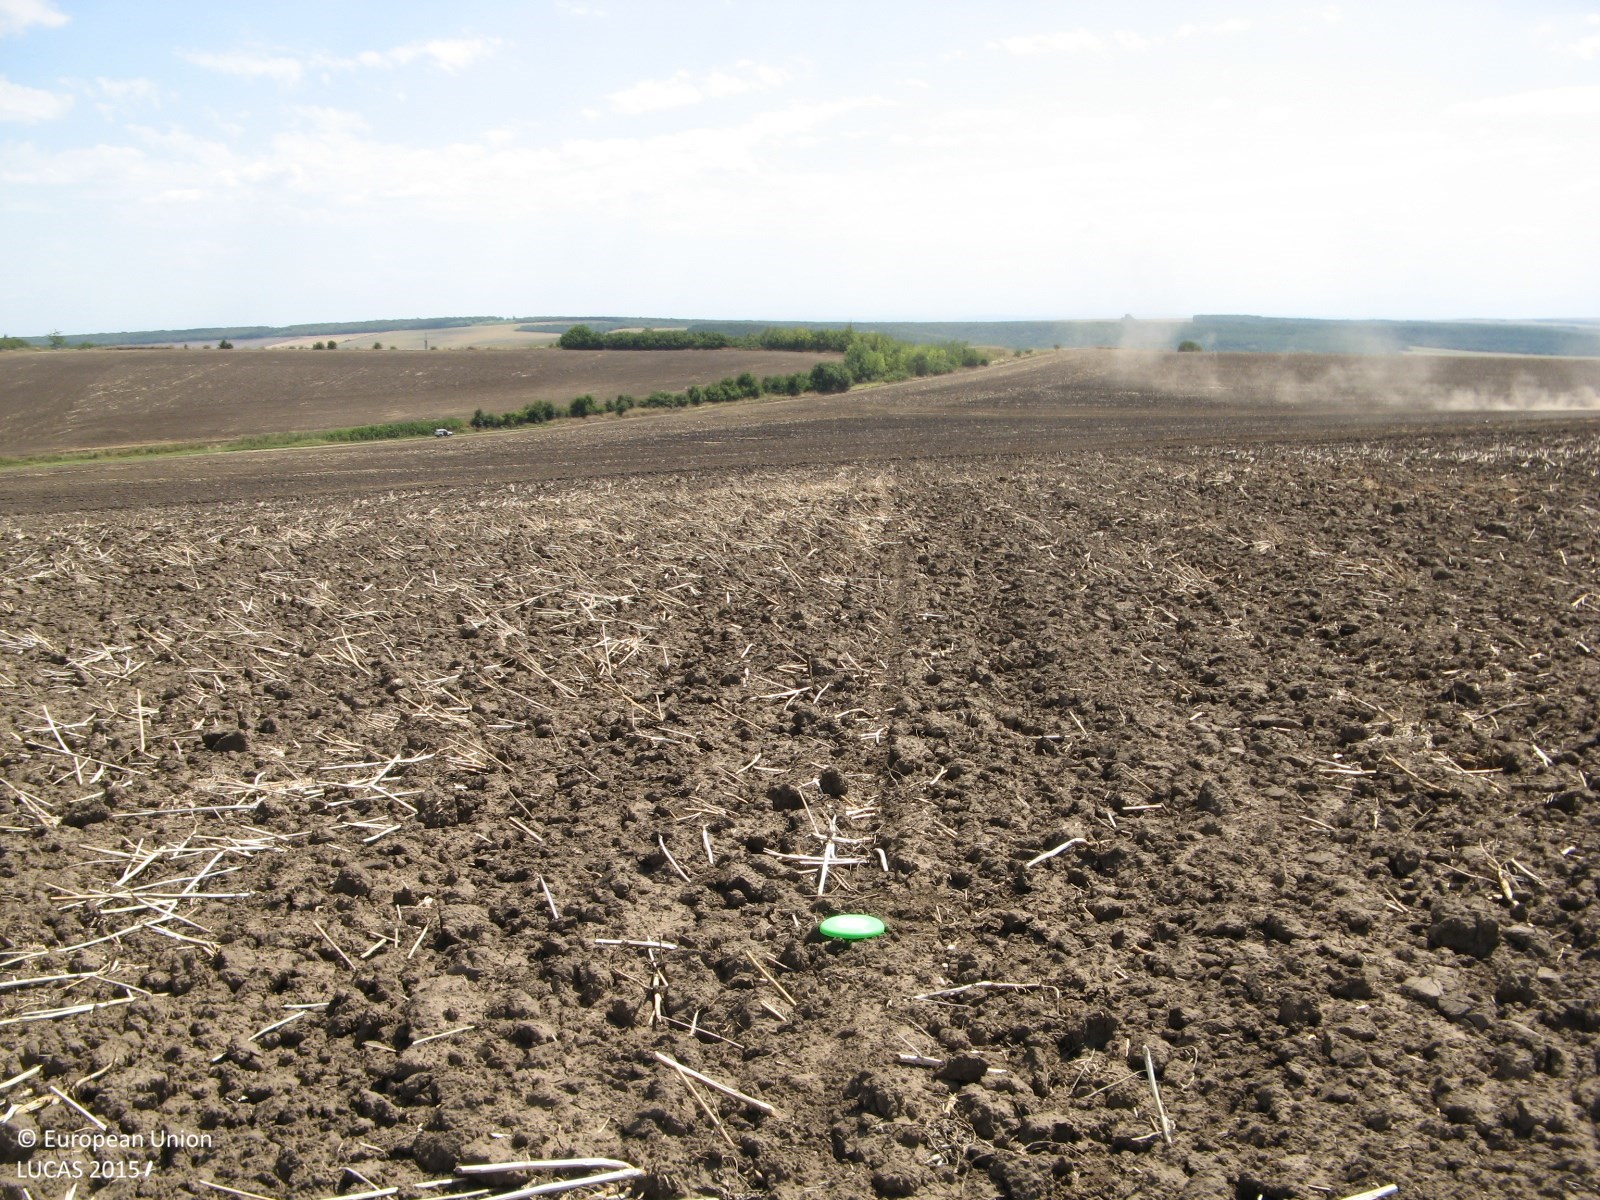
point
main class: Cropland
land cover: Rape and turnip rape
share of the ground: < 10 %
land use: Agriculture (excluding fallow land and kitchen gardens)
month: August
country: BG
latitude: 43.4797
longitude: 25.3215
